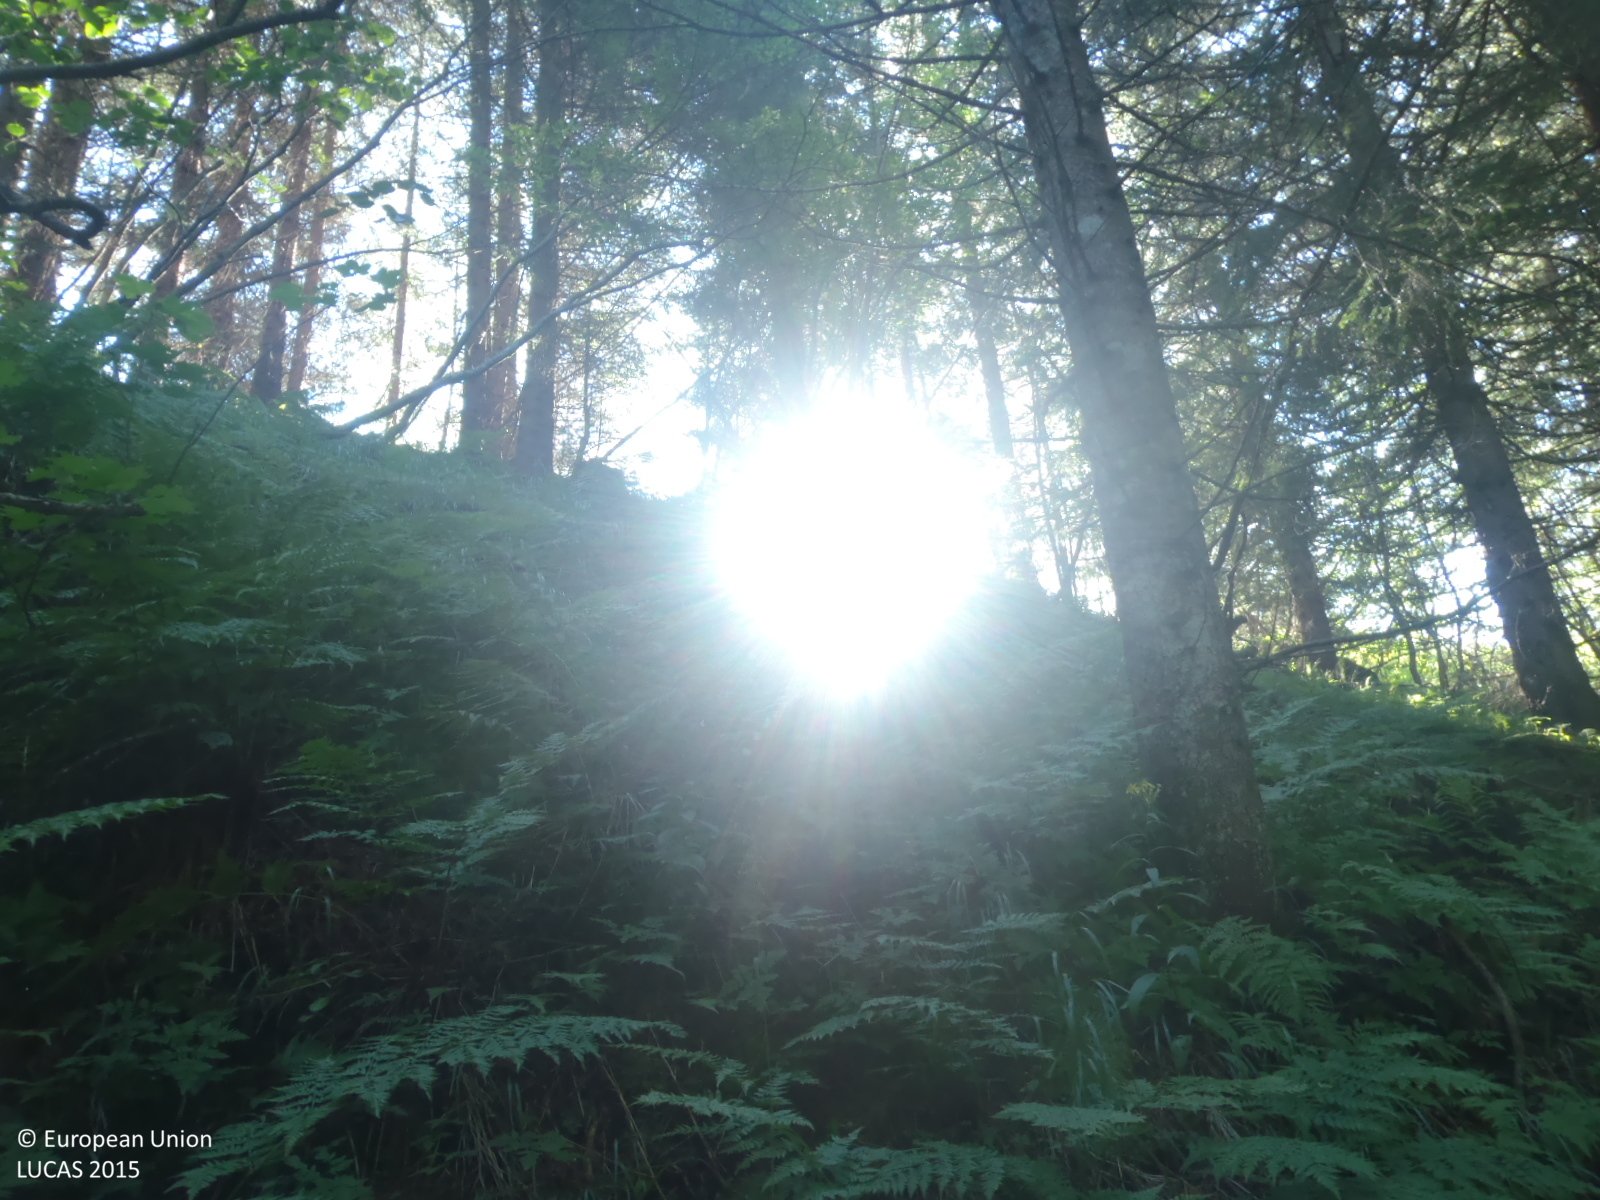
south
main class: Woodland
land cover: Spruce dominated coniferous woodland
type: alpine coniferous forest
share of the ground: > 75 %
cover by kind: coniferous forest trees 95 %, broadleaved forest trees 5 %
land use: Forestry
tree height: > 5 m
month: August
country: AT
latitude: 47.0964
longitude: 12.5143
